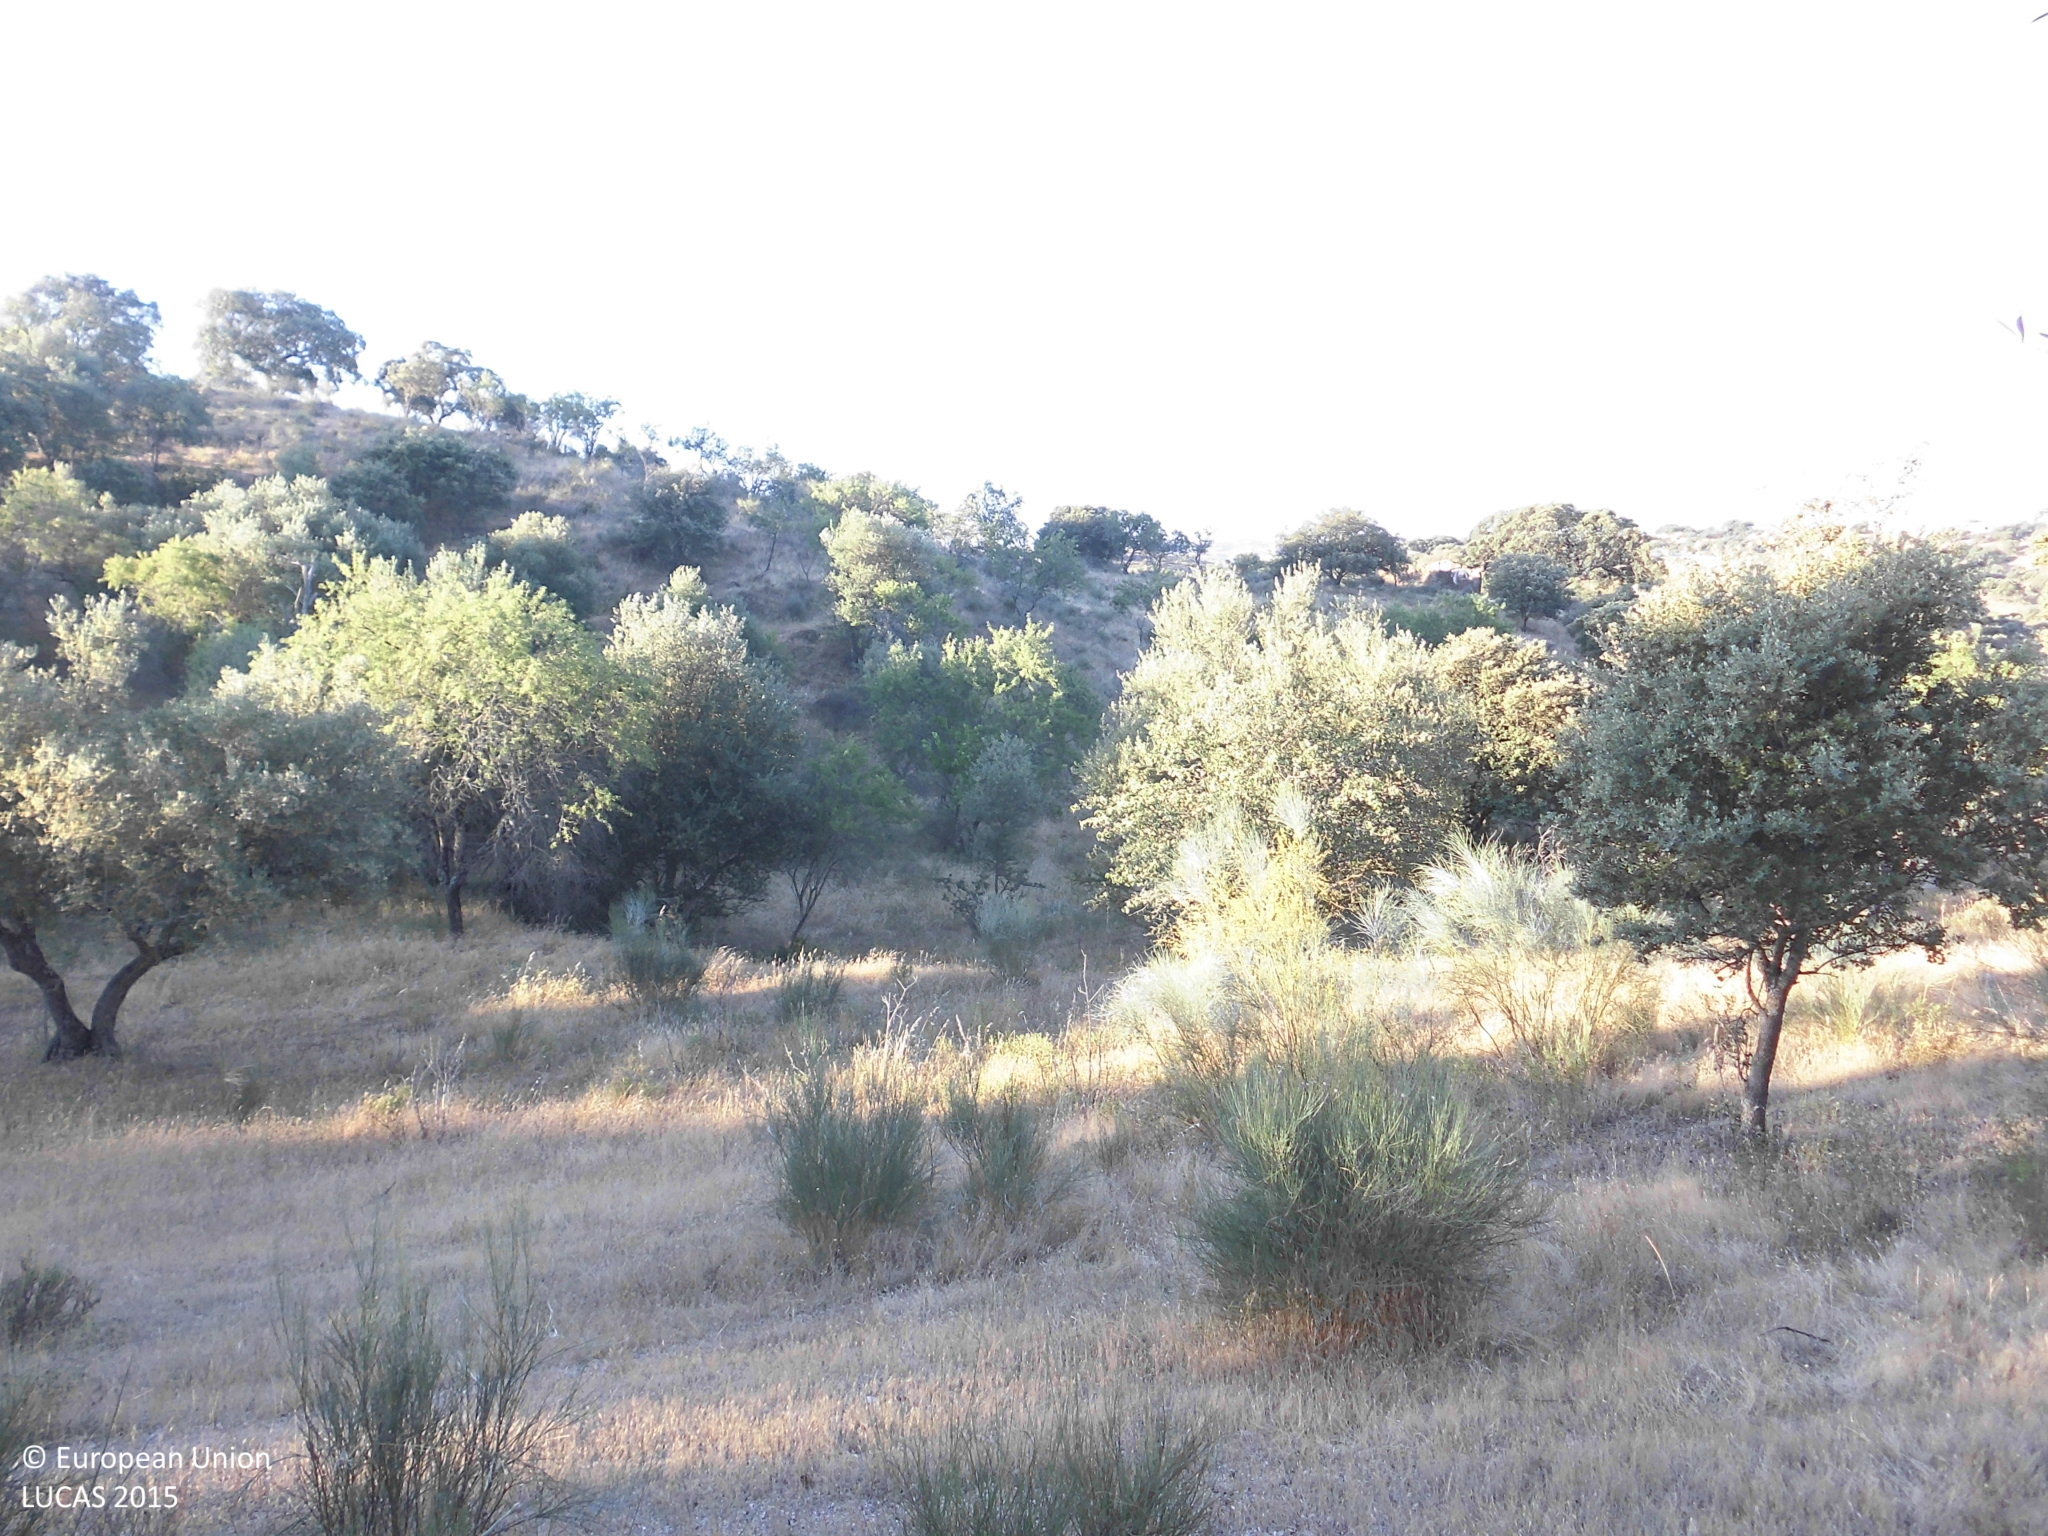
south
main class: Cropland
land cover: Olive groves
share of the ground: 10 - 25 %
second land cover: Spontaneously vegetated surfaces
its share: 50 - 75 %
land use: Agriculture (excluding fallow land and kitchen gardens)
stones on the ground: 10 - 25 %
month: May
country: ES
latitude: 39.7875
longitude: -6.6728
